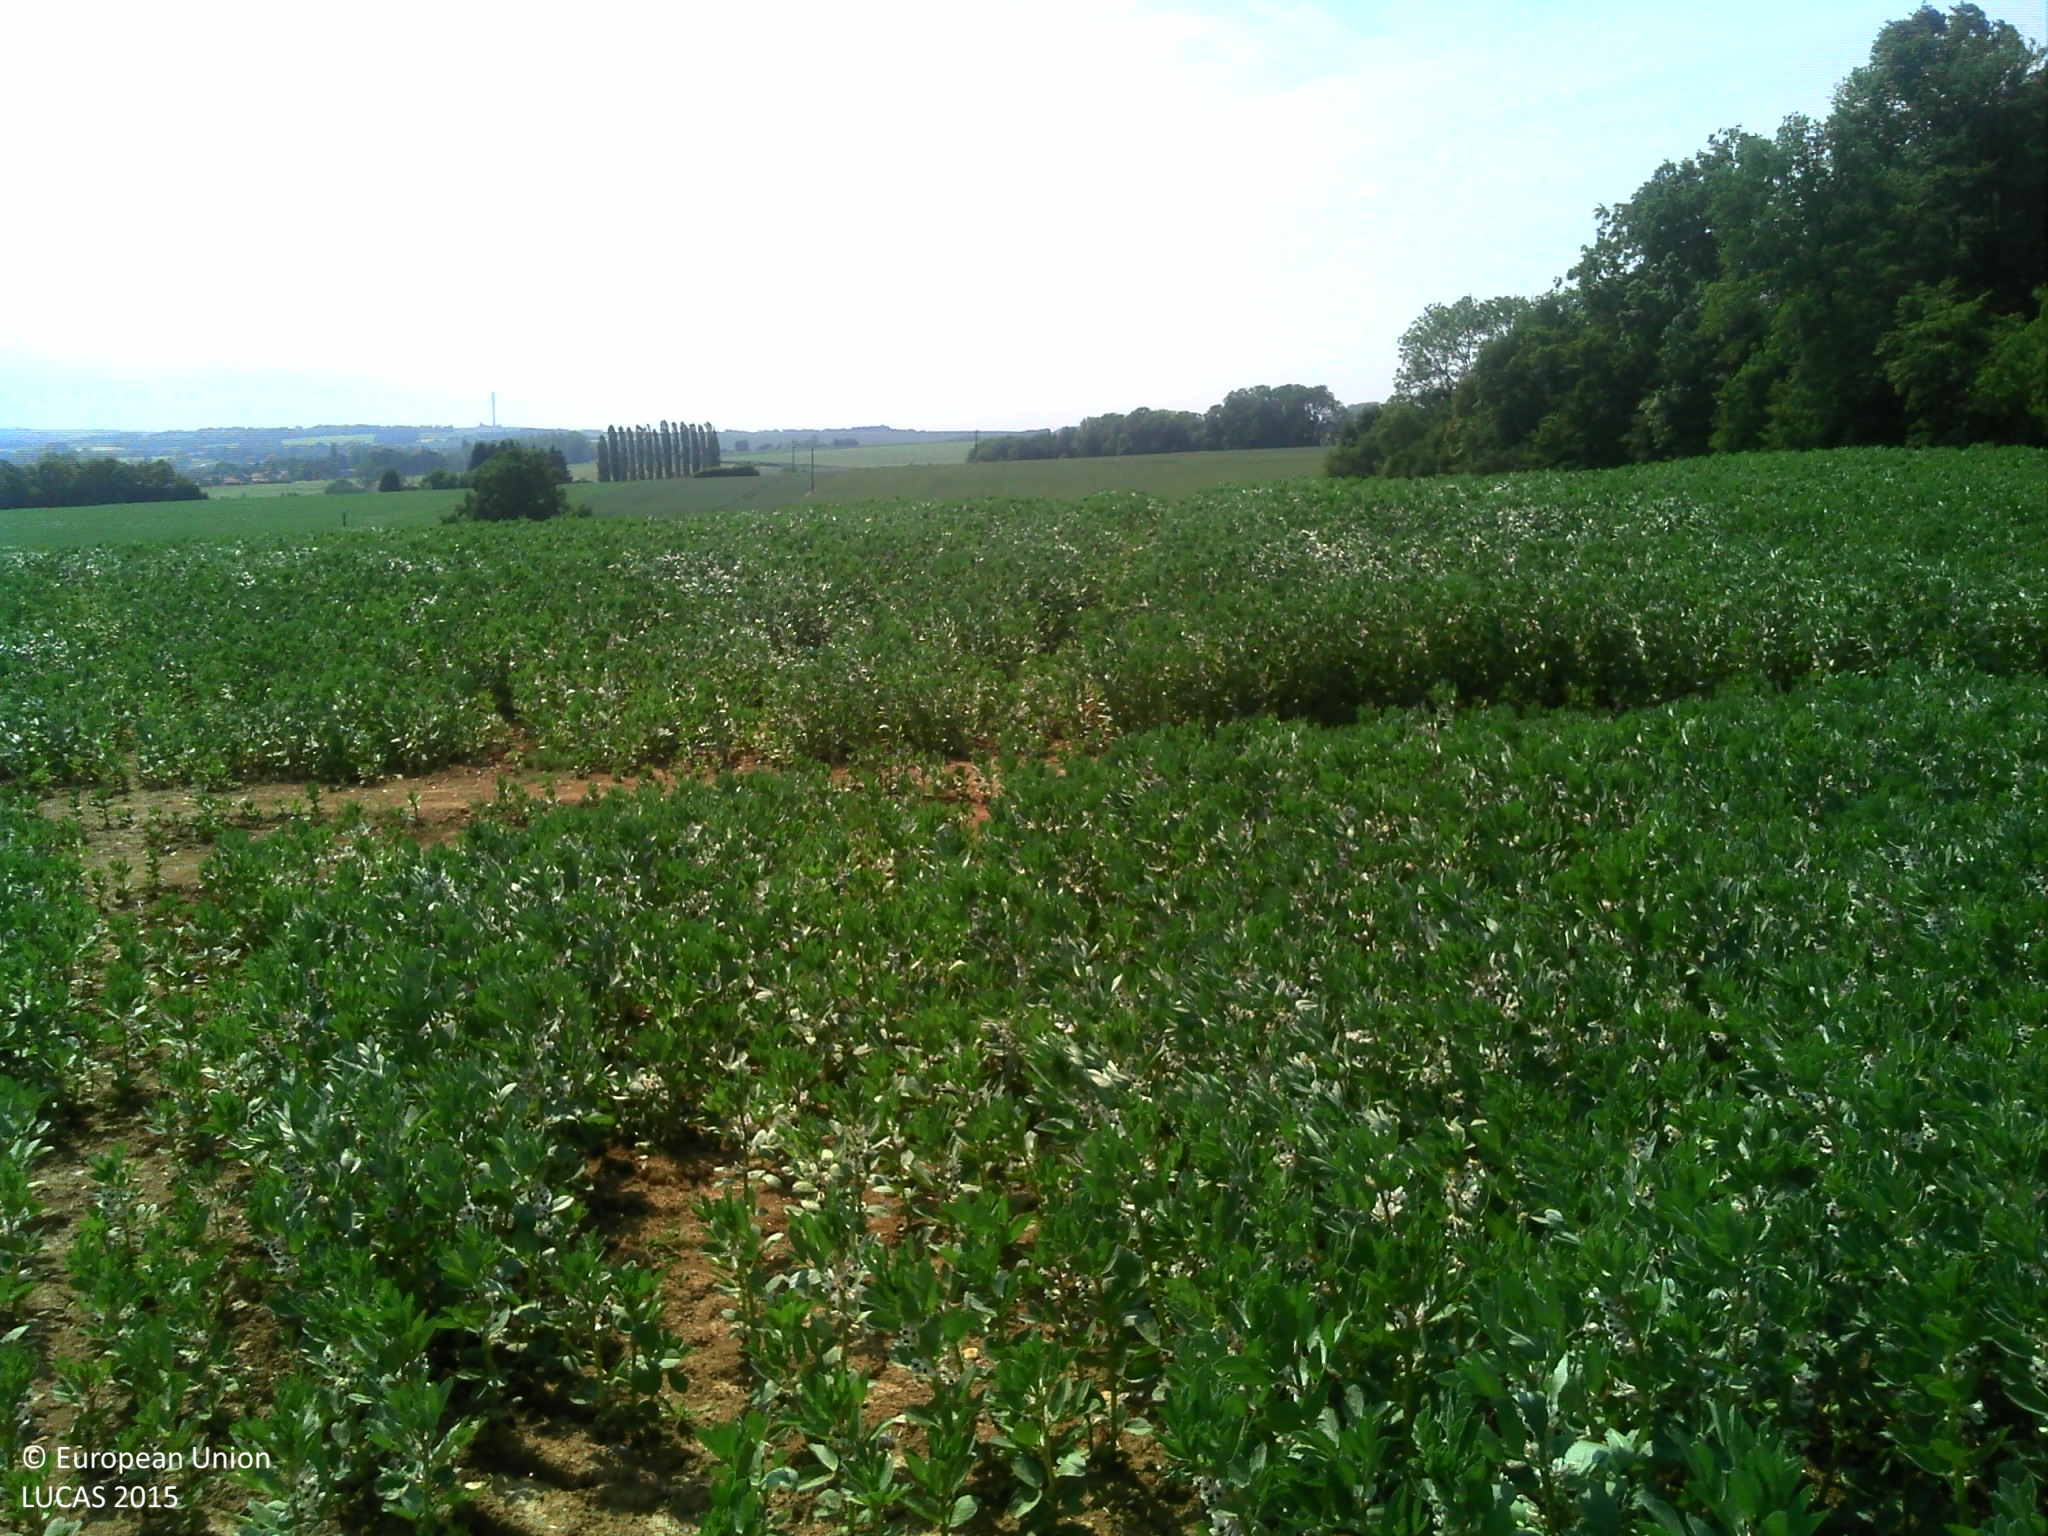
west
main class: Cropland
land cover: Dry pulses
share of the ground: > 75 %
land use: Agriculture (excluding fallow land and kitchen gardens)
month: June
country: FR
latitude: 49.7249
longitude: 4.0993
